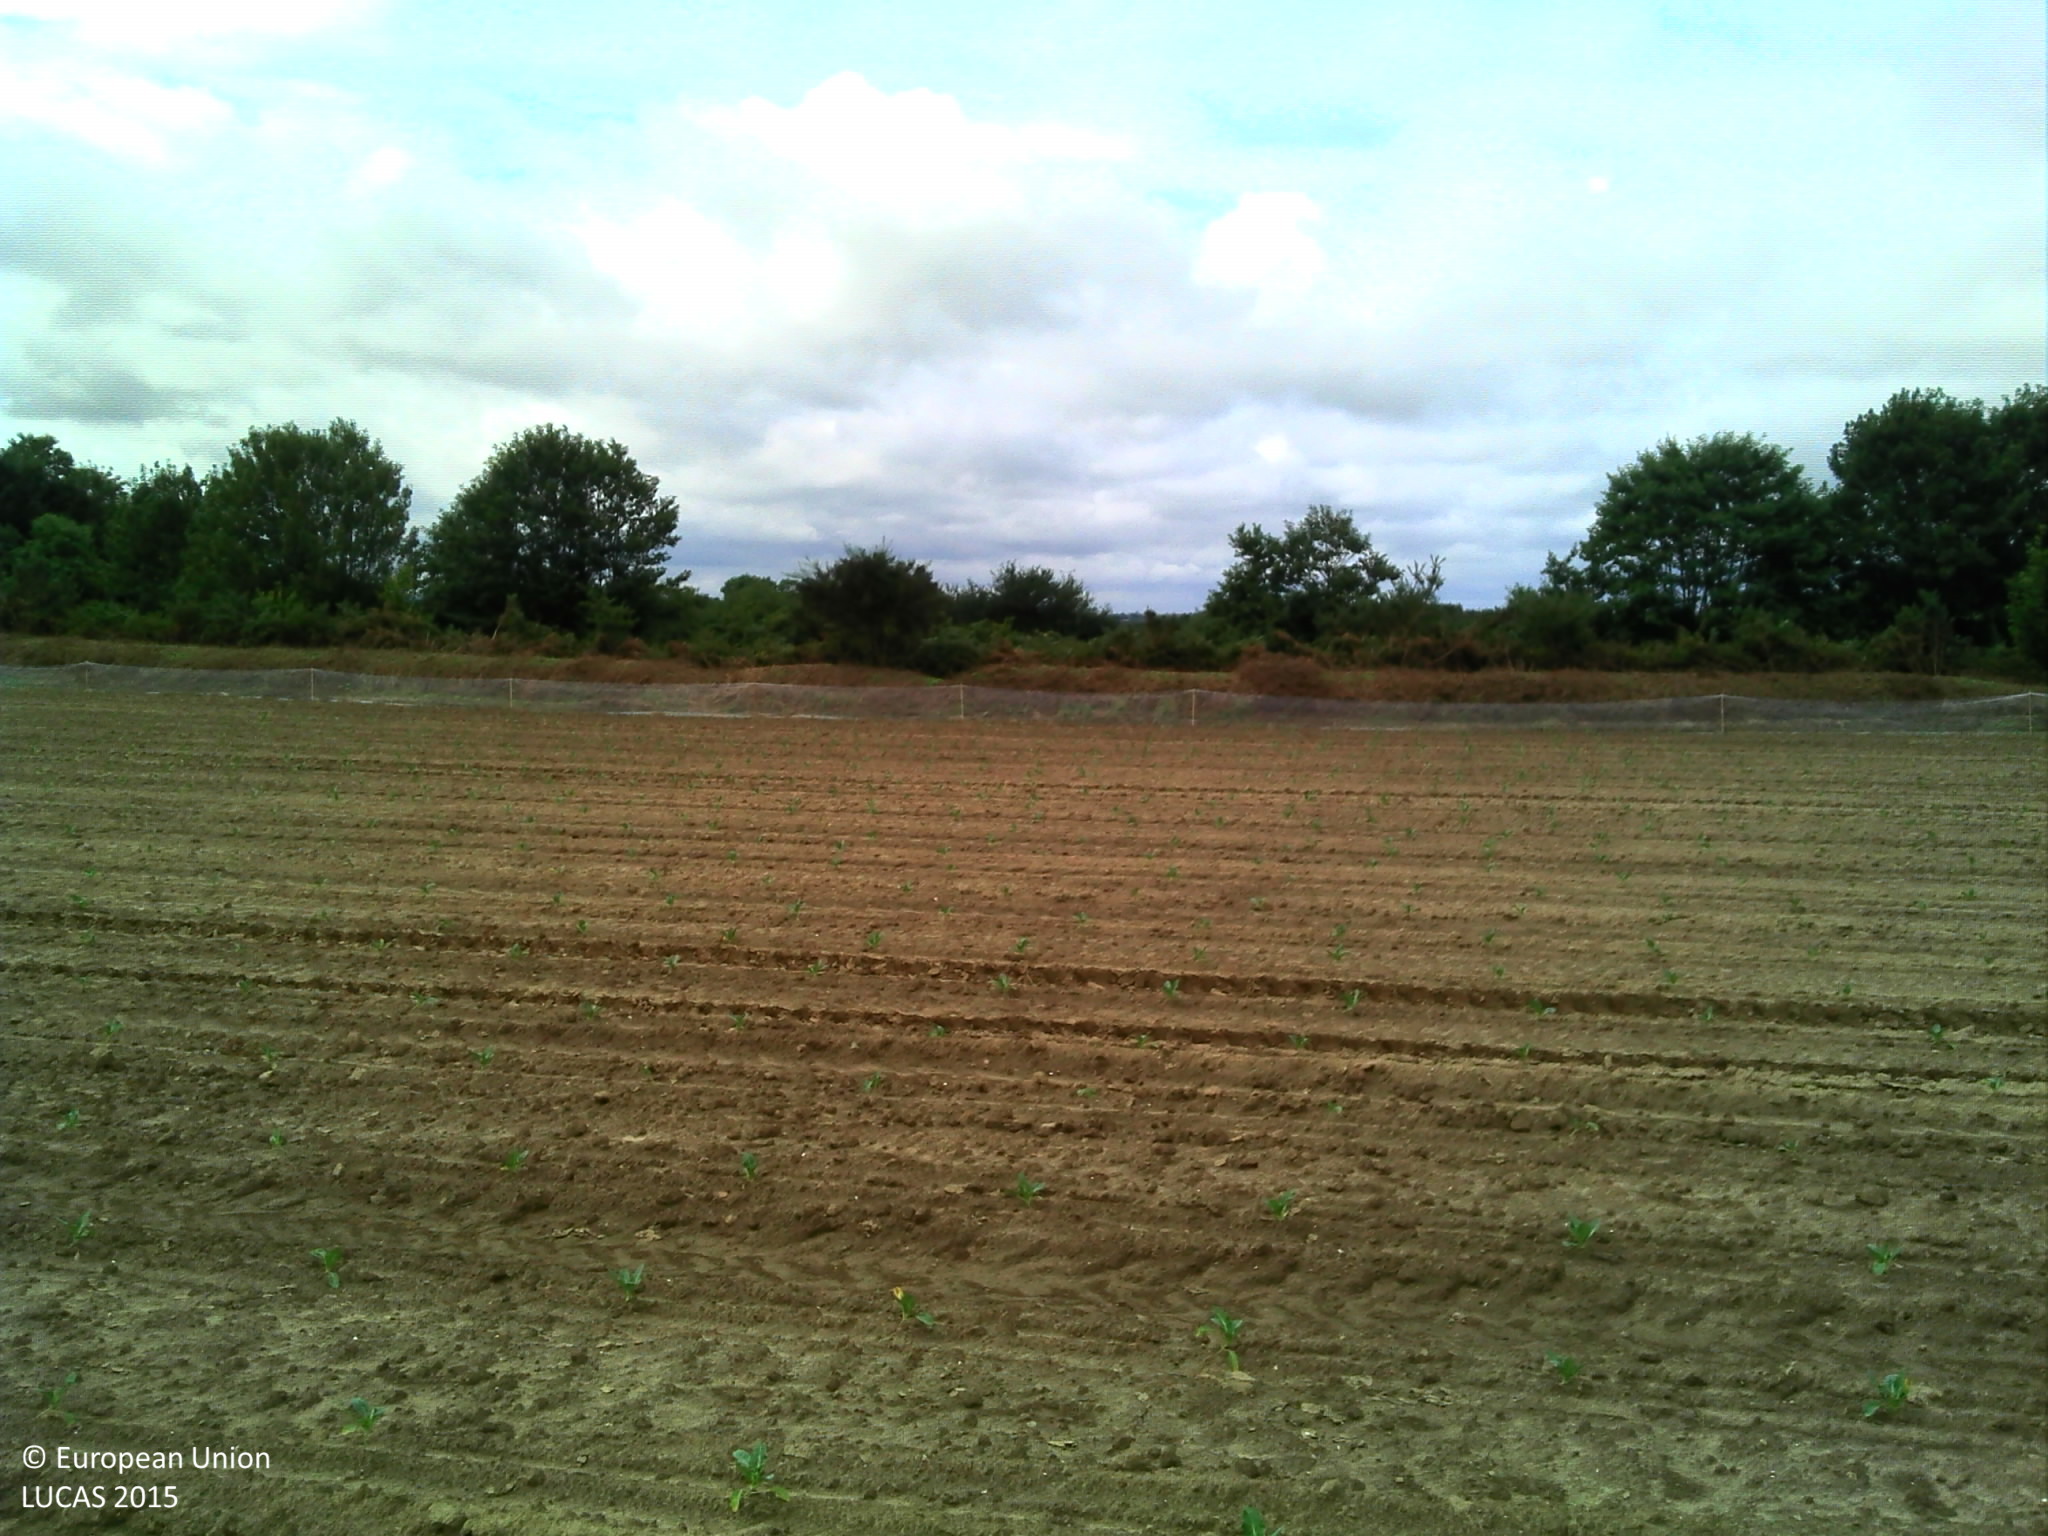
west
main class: Cropland
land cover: Other fresh vegetables
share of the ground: < 10 %
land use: Agriculture (excluding fallow land and kitchen gardens)
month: August
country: FR
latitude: 48.7739
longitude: -3.2056
